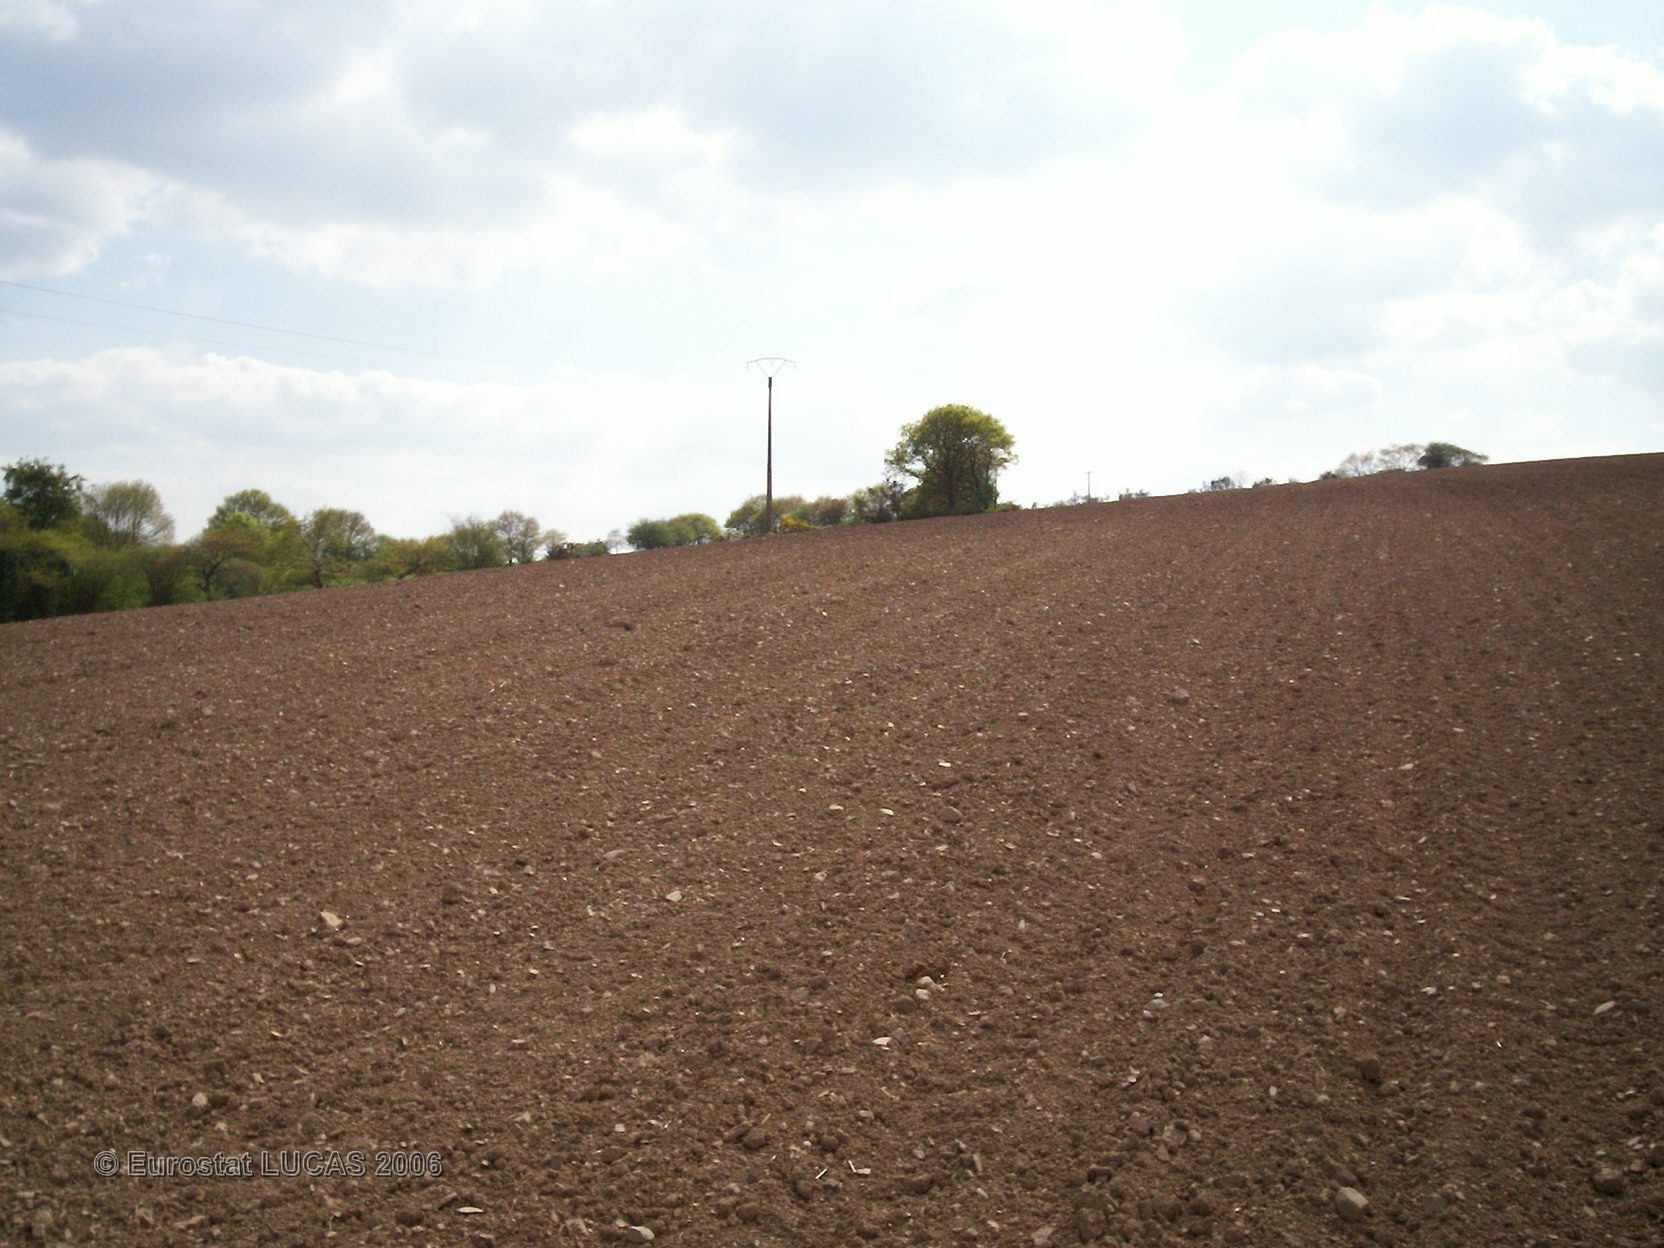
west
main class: Cropland
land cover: Maize
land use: Agriculture (excluding fallow land and kitchen gardens)
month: May
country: FR
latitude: 48.4085
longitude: -3.6585
